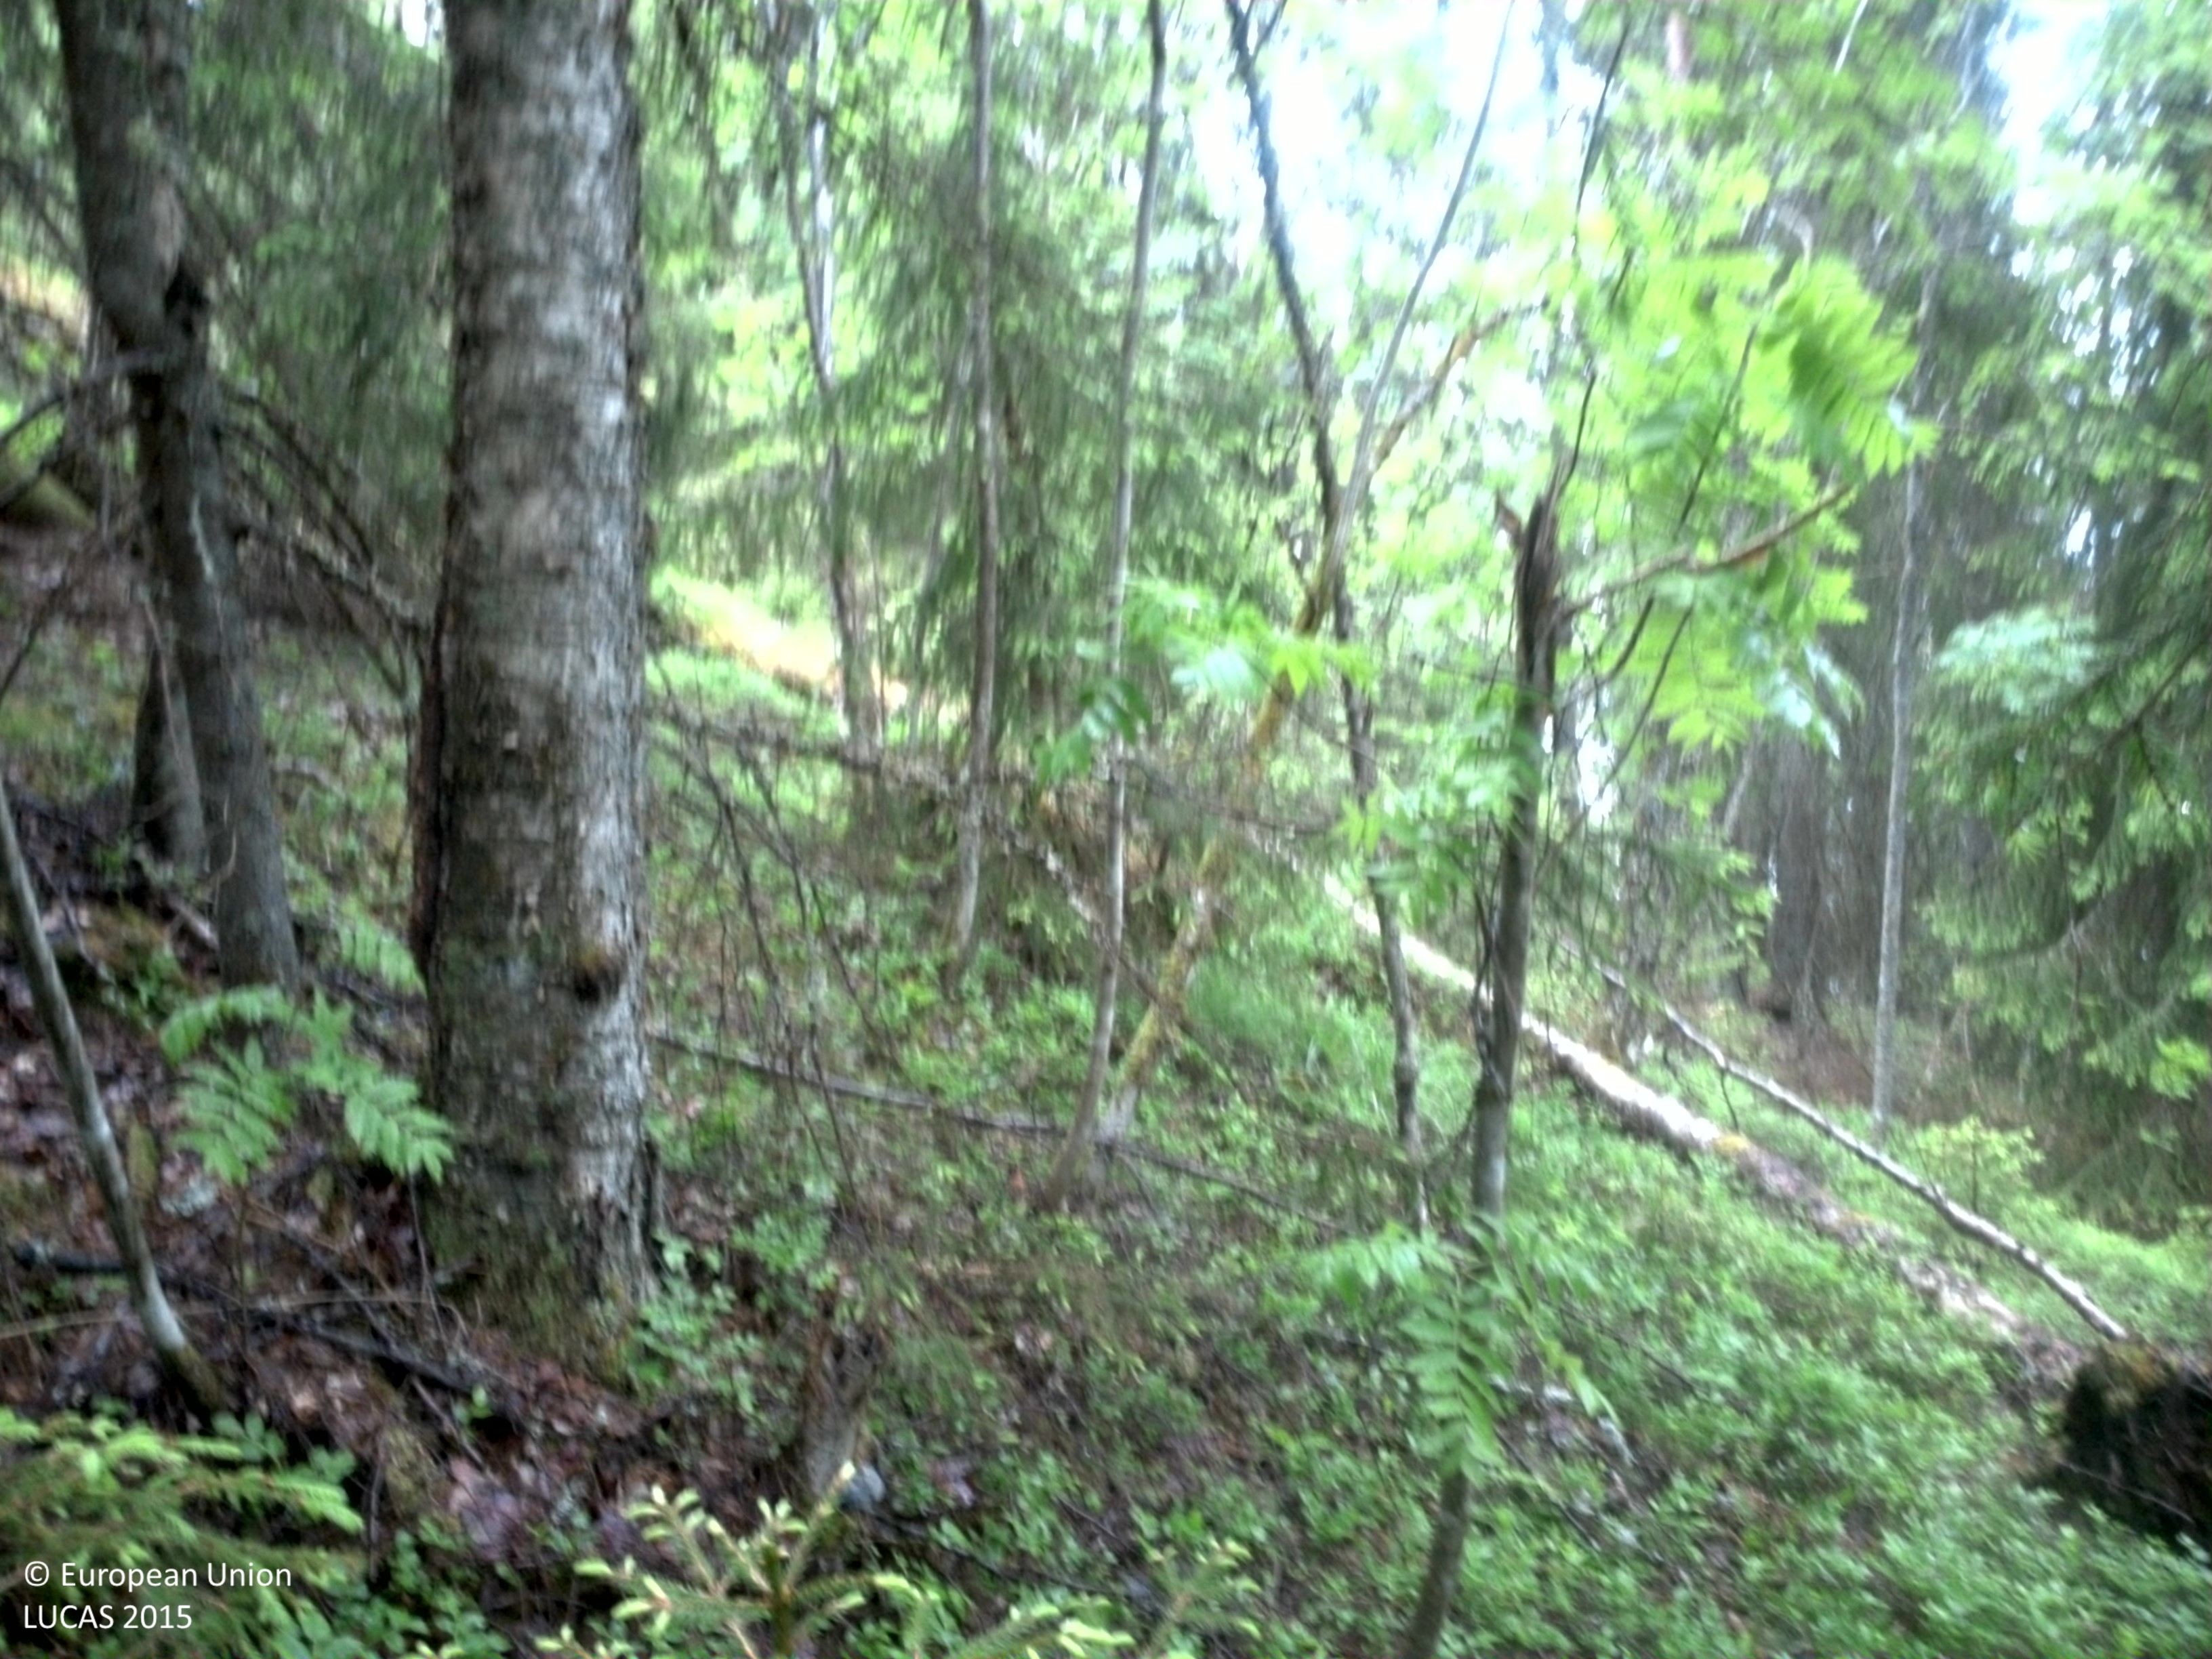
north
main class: Woodland
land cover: Spruce dominated coniferous woodland
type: boreal forest
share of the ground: > 75 %
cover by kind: coniferous forest trees 75 %, shrubs 10 %, broadleaved forest trees 5 %, herbaceous plants 5 %, lichens and mosses 5 %
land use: Forestry
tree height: > 5 m
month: June
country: SE
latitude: 59.7152
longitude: 12.0743
